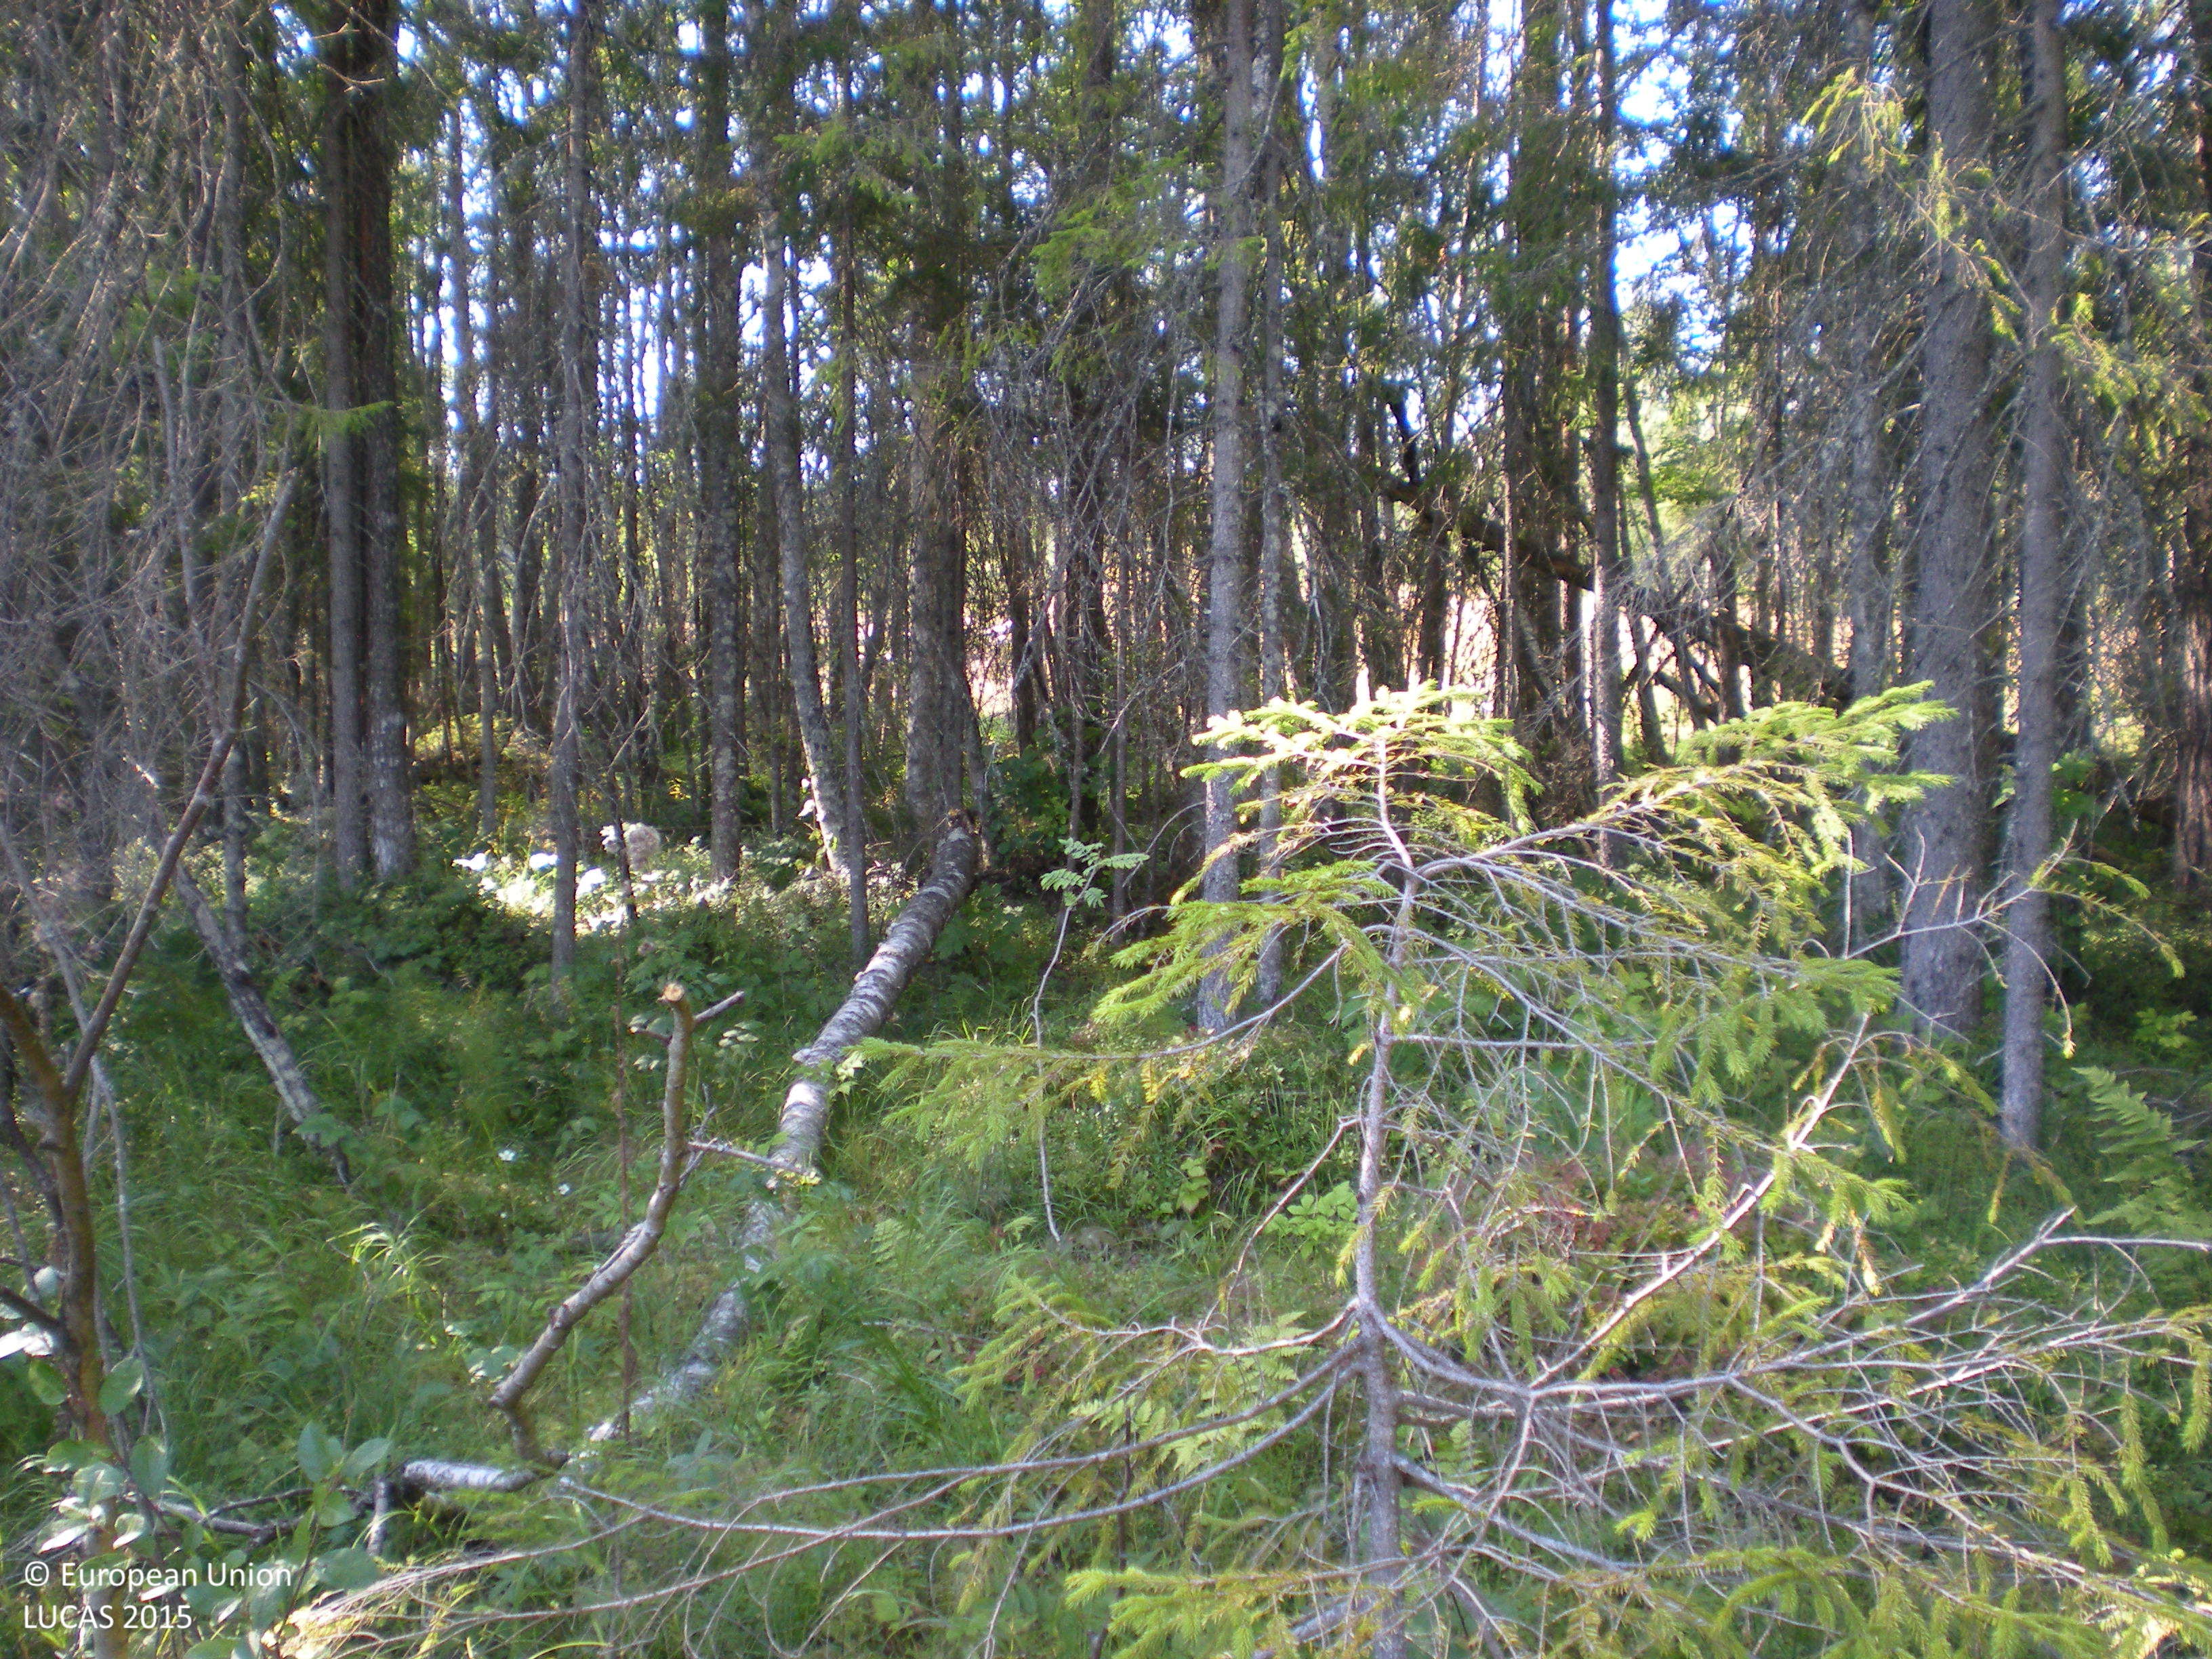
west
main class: Woodland
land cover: Other mixed woodland
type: boreal forest
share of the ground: 50 - 75 %
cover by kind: coniferous forest trees 50 %, broadleaved forest trees 20 %, shrubs 20 %, herbaceous plants 5 %, lichens and mosses 5 %
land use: Forestry
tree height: > 5 m
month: August
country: SE
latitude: 60.5899
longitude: 17.2739
